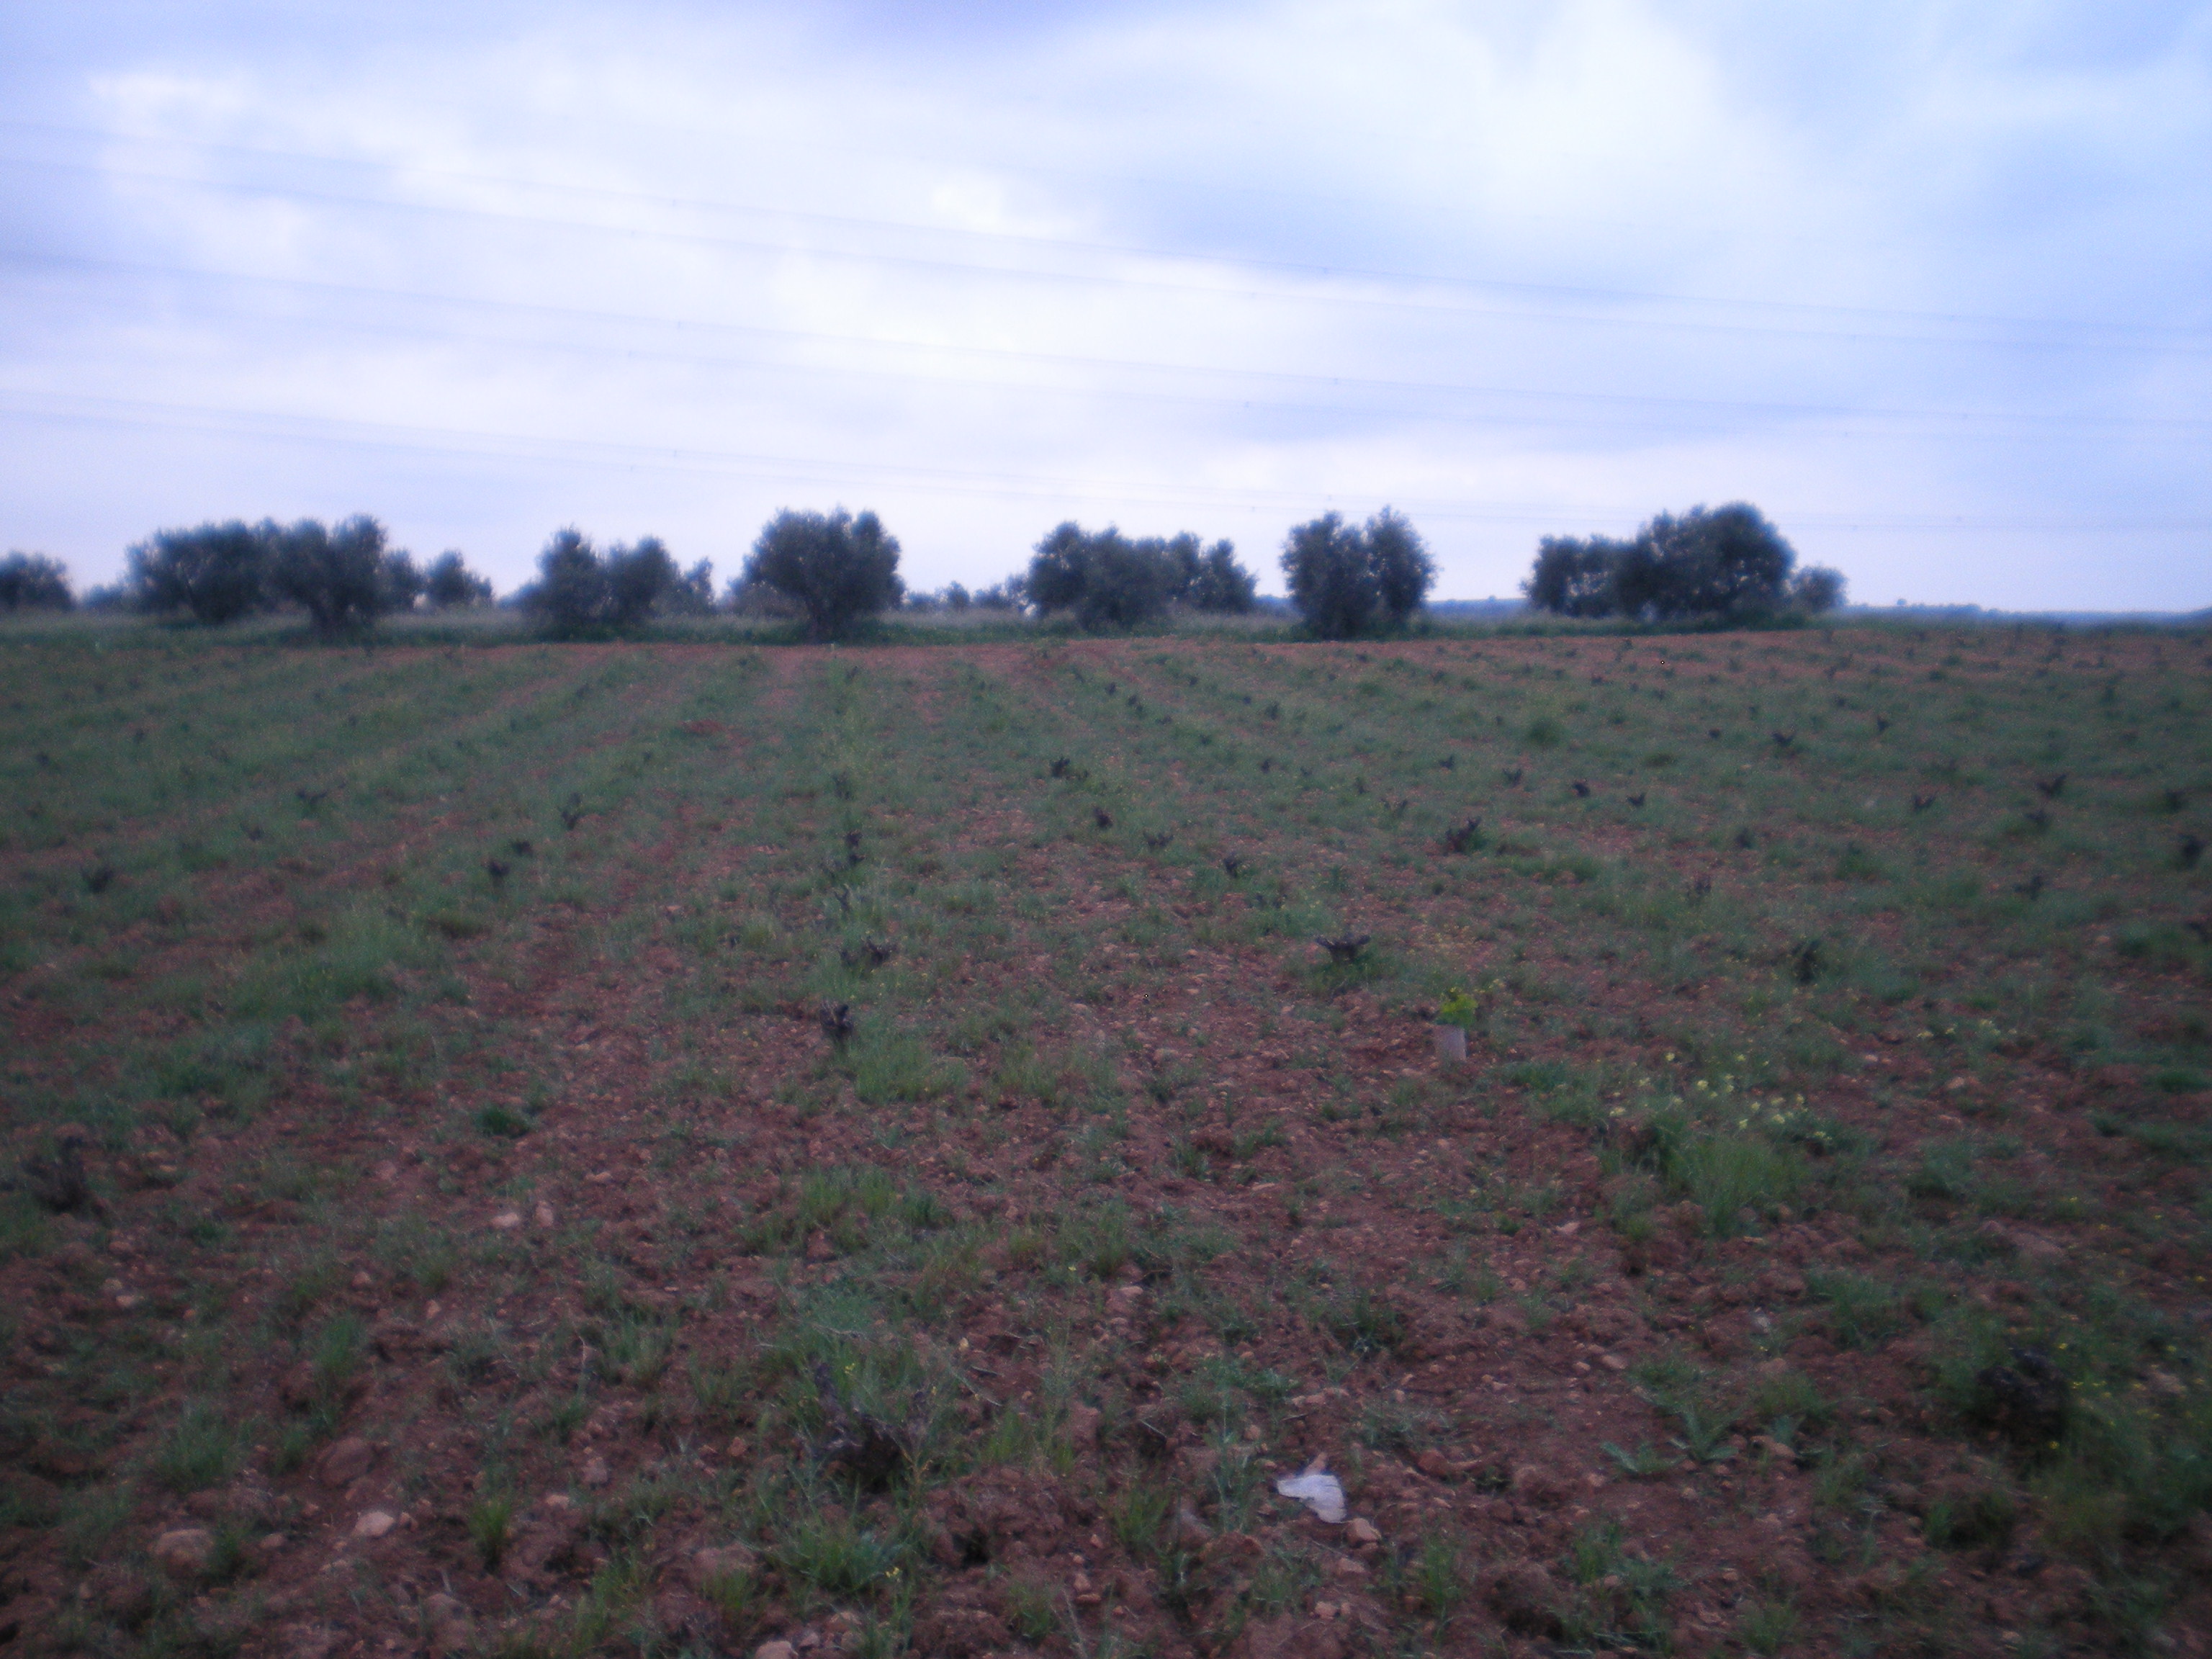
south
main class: Cropland
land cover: Vineyards
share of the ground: < 10 %
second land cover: Spontaneously vegetated surfaces
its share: 25 - 50 %
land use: Agriculture (excluding fallow land and kitchen gardens)
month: April
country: ES
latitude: 38.7809
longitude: -3.4921
